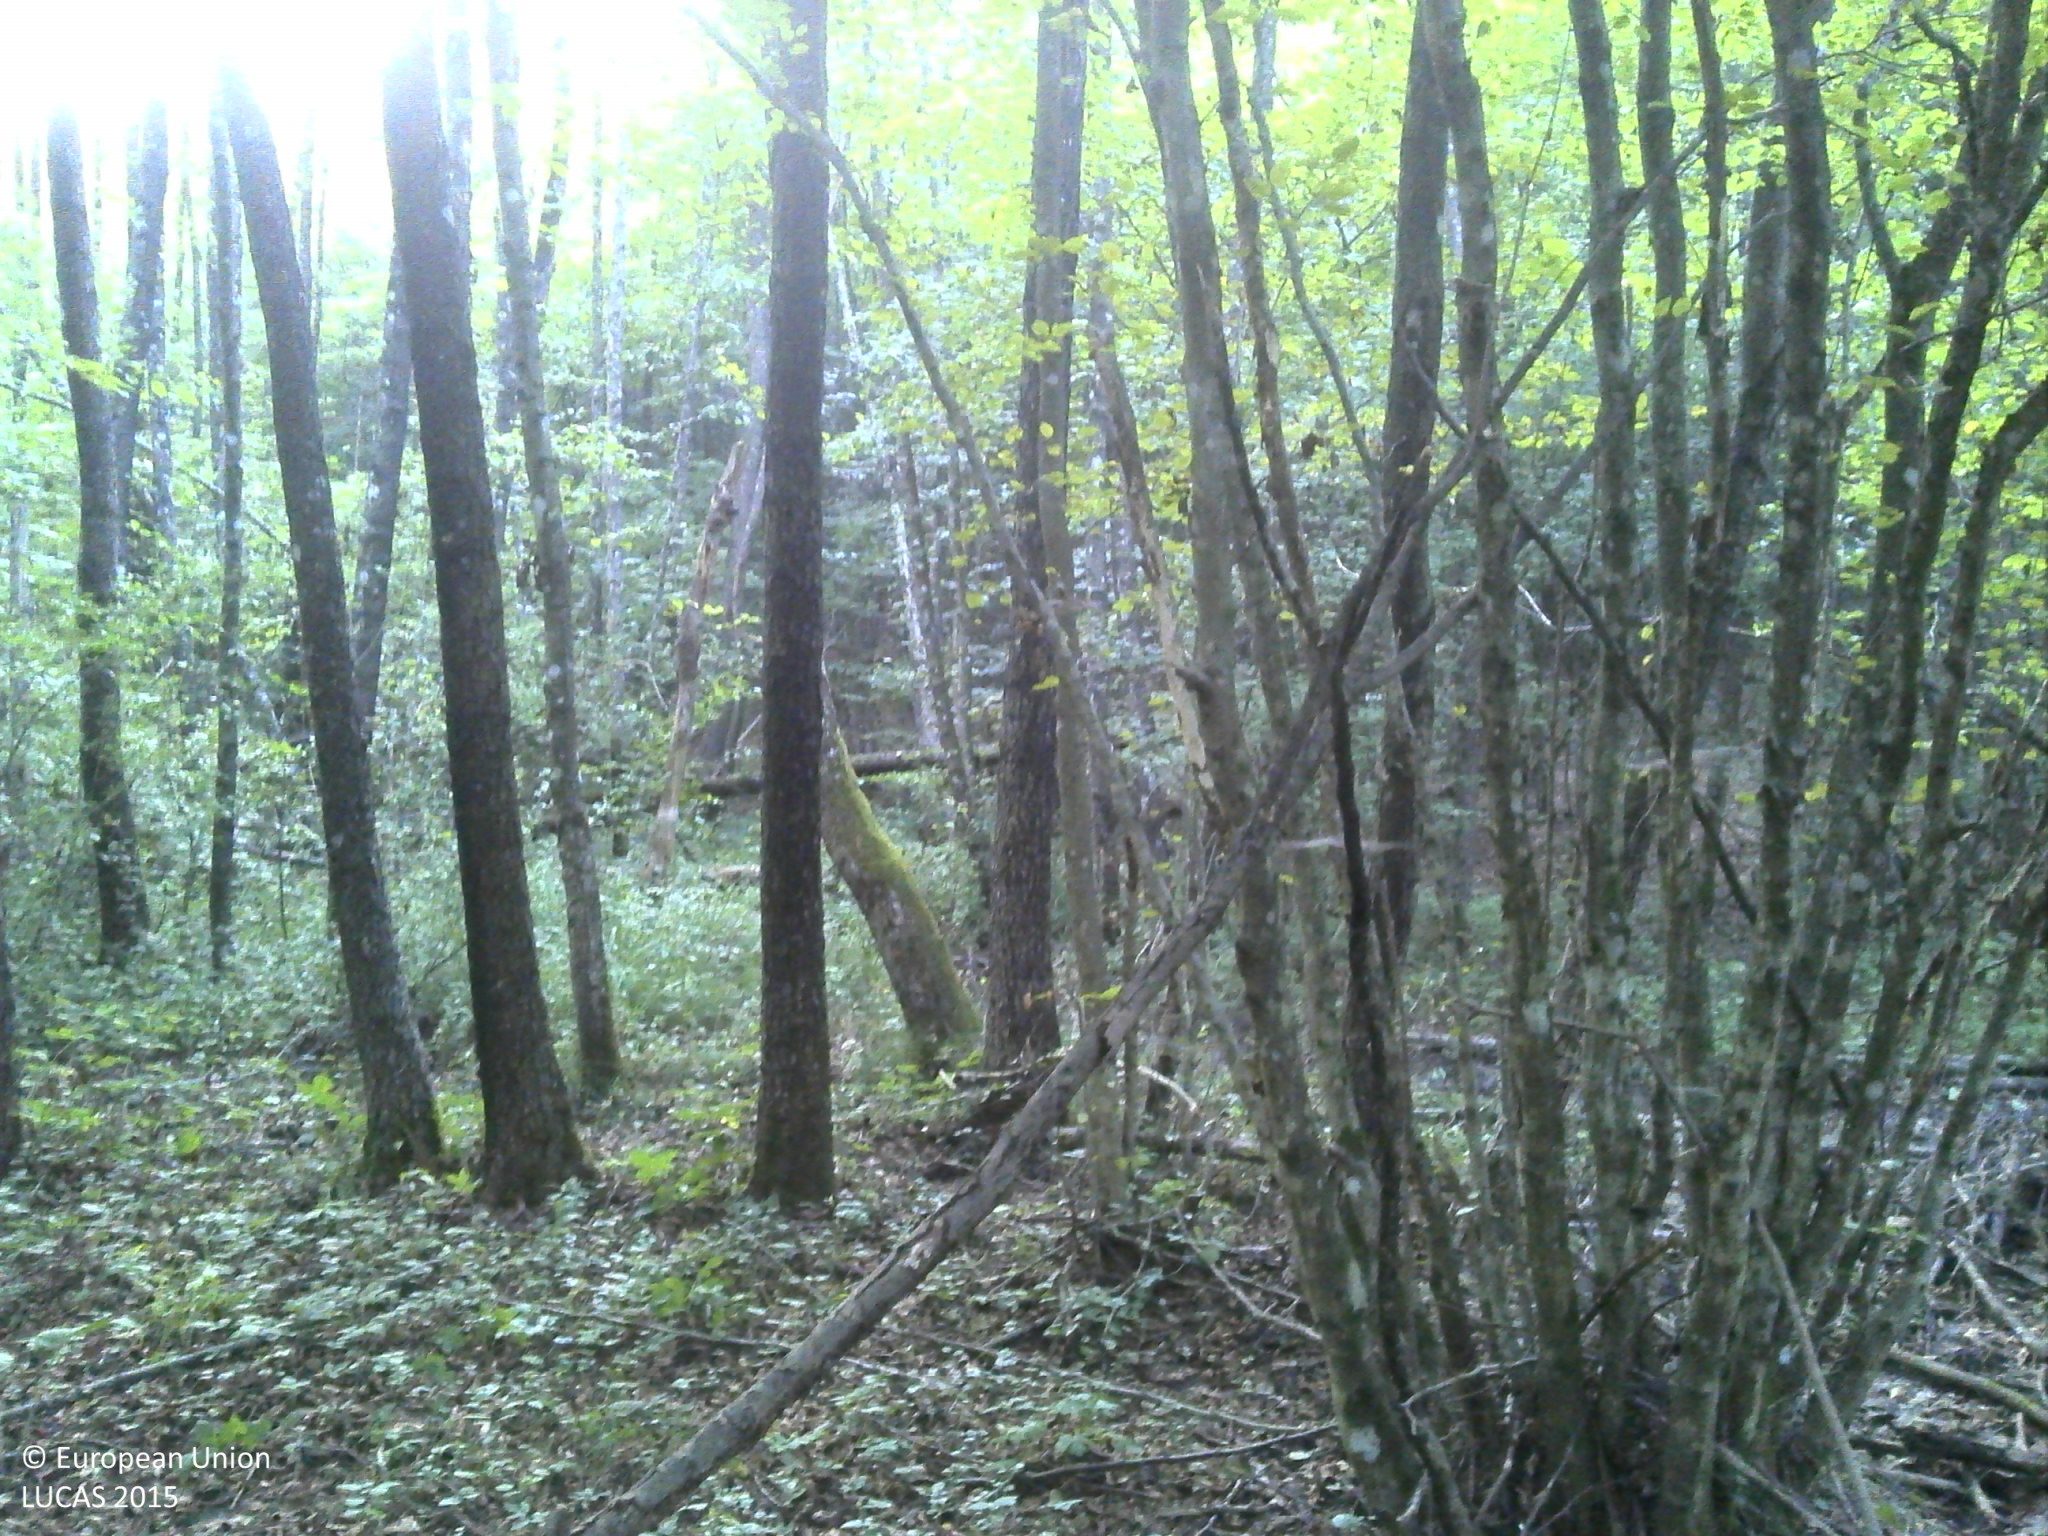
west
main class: Woodland
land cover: Broadleaved woodland
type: acidophilous oak and oak-birch forest
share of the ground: > 75 %
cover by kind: broadleaved forest trees 100 %
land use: Forestry
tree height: > 5 m
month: September
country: HR
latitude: 45.4891
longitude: 16.1262
